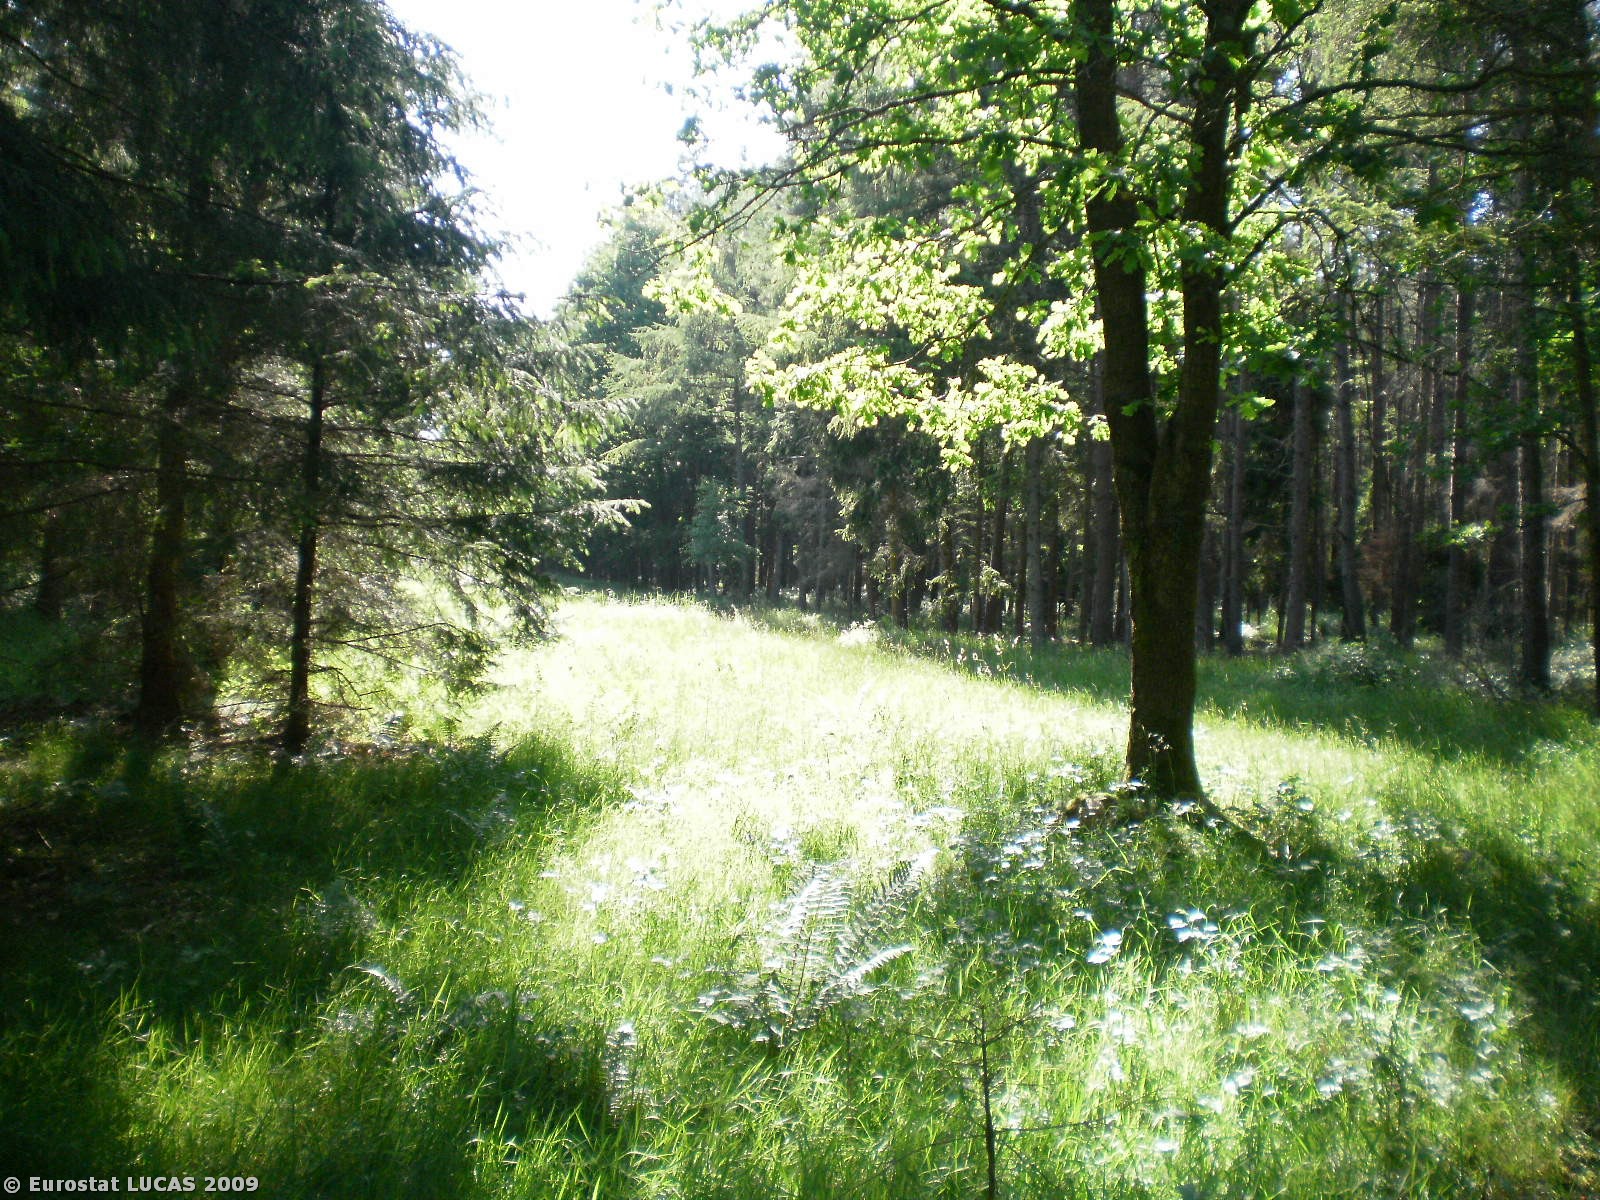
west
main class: Woodland
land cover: Coniferous woodland
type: hemiboreal forest and nemoral coniferous forest and mixed broadleaved-coniferous forest
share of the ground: > 75 %
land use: Forestry
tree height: > 5 m
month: June
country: PL
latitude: 54.4271
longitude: 17.3003
